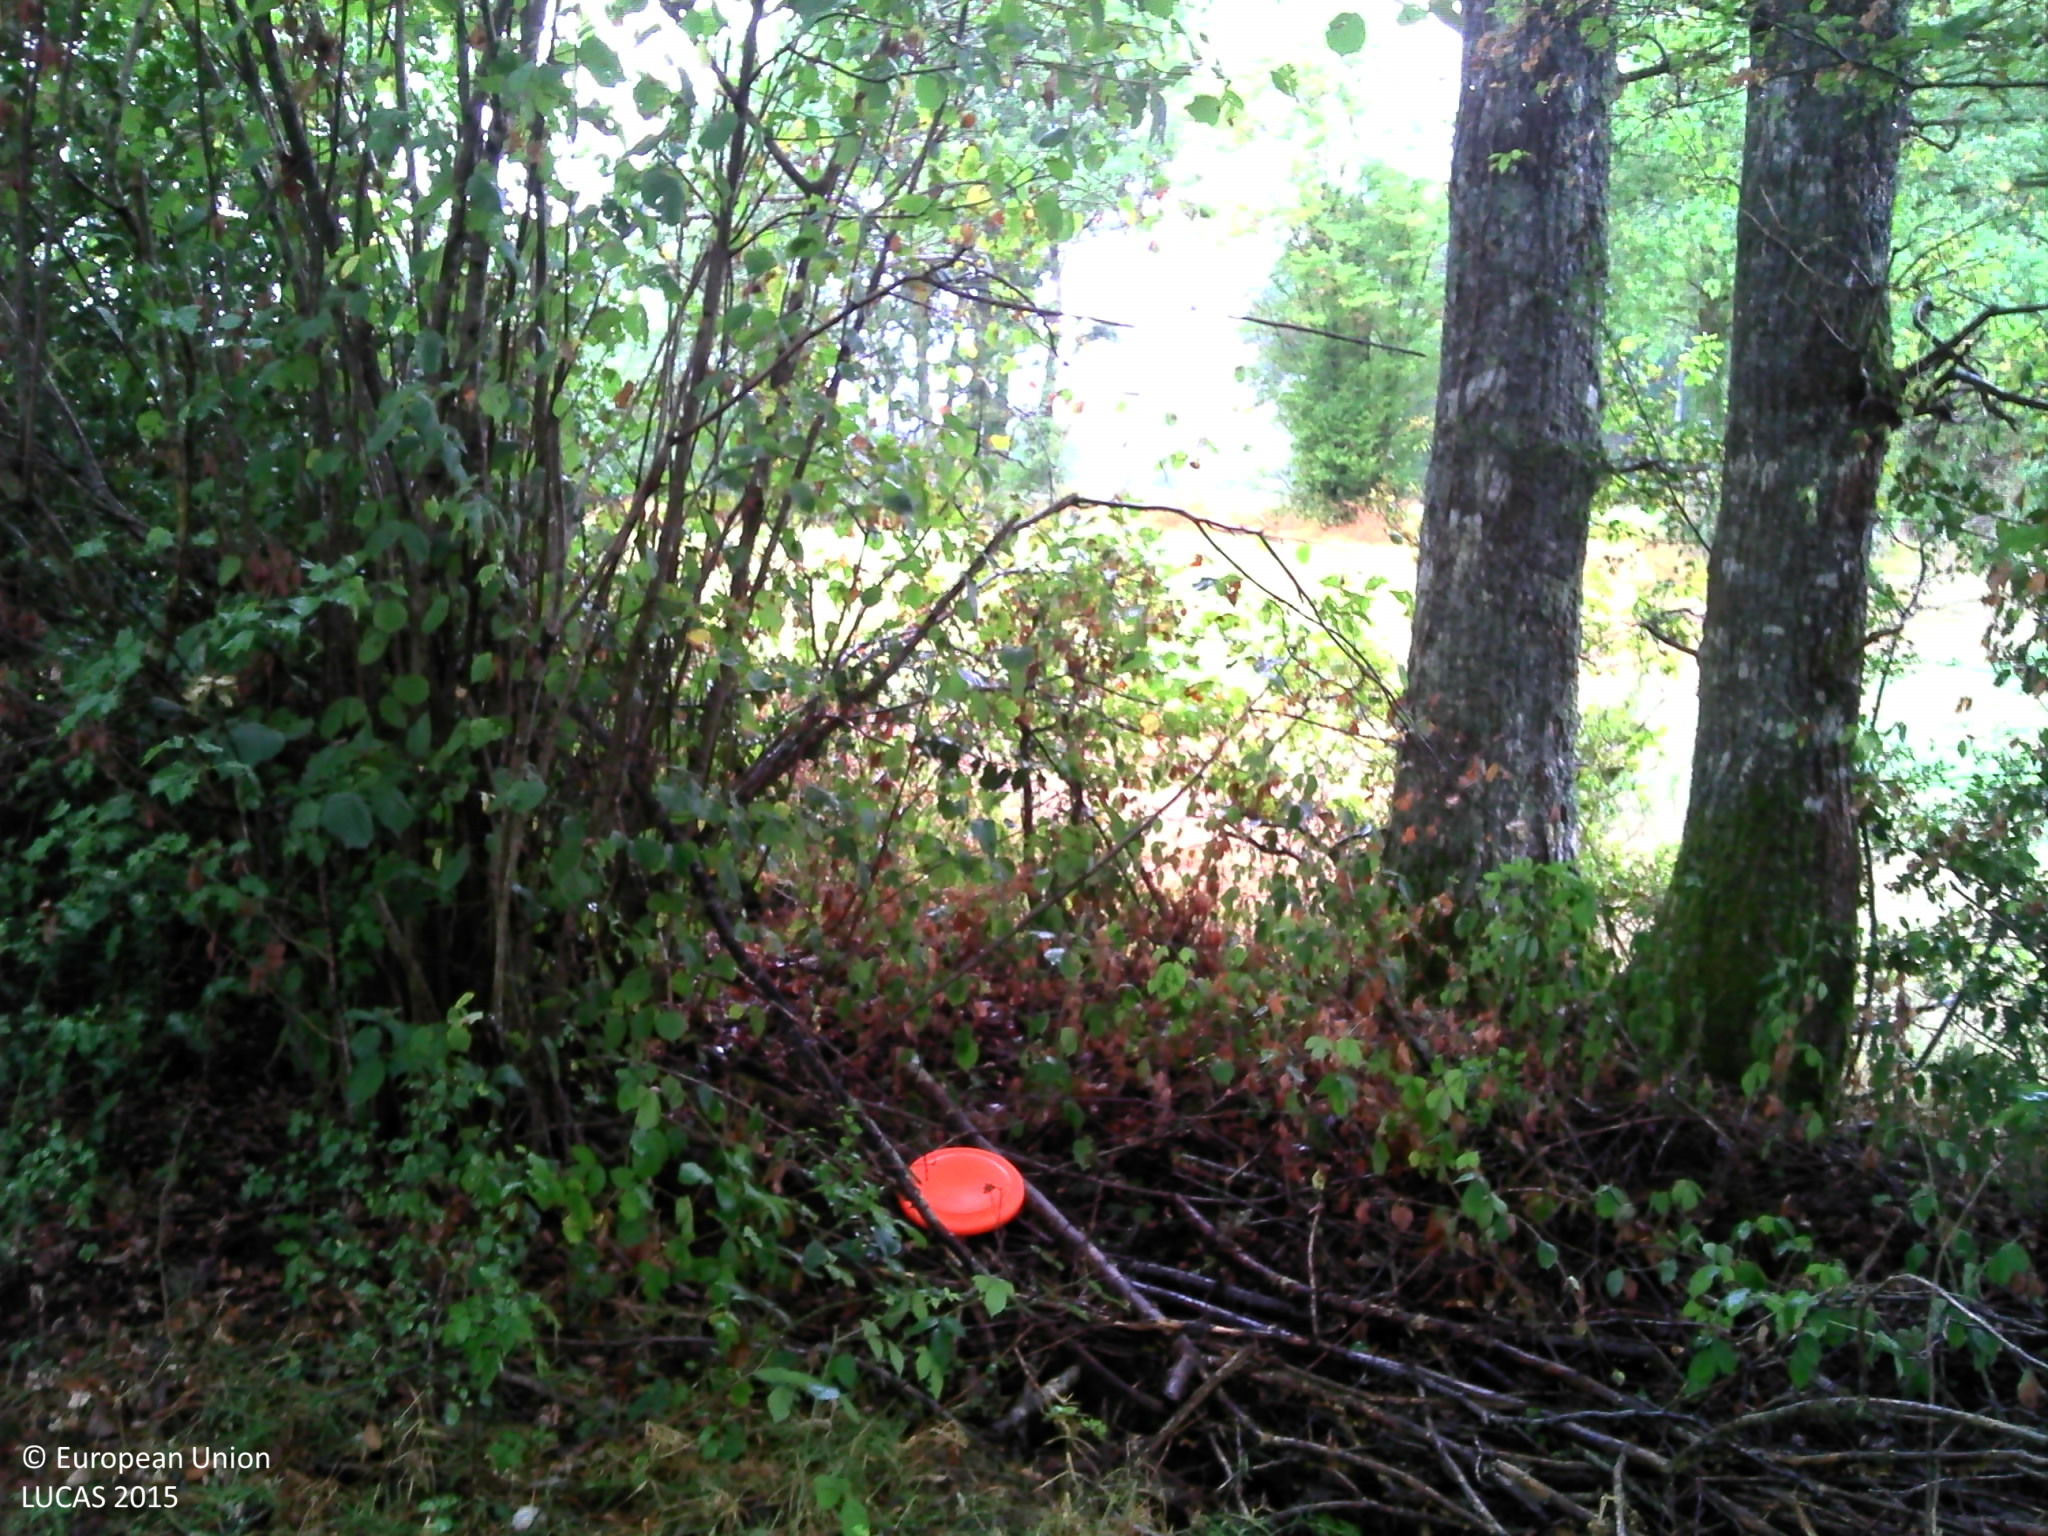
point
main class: Grassland
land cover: Grassland without tree/shrub cover
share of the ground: > 75 %
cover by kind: herbaceous plants 100 %
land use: Agriculture (excluding fallow land and kitchen gardens)
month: August
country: FR
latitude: 47.6127
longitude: 3.1432
